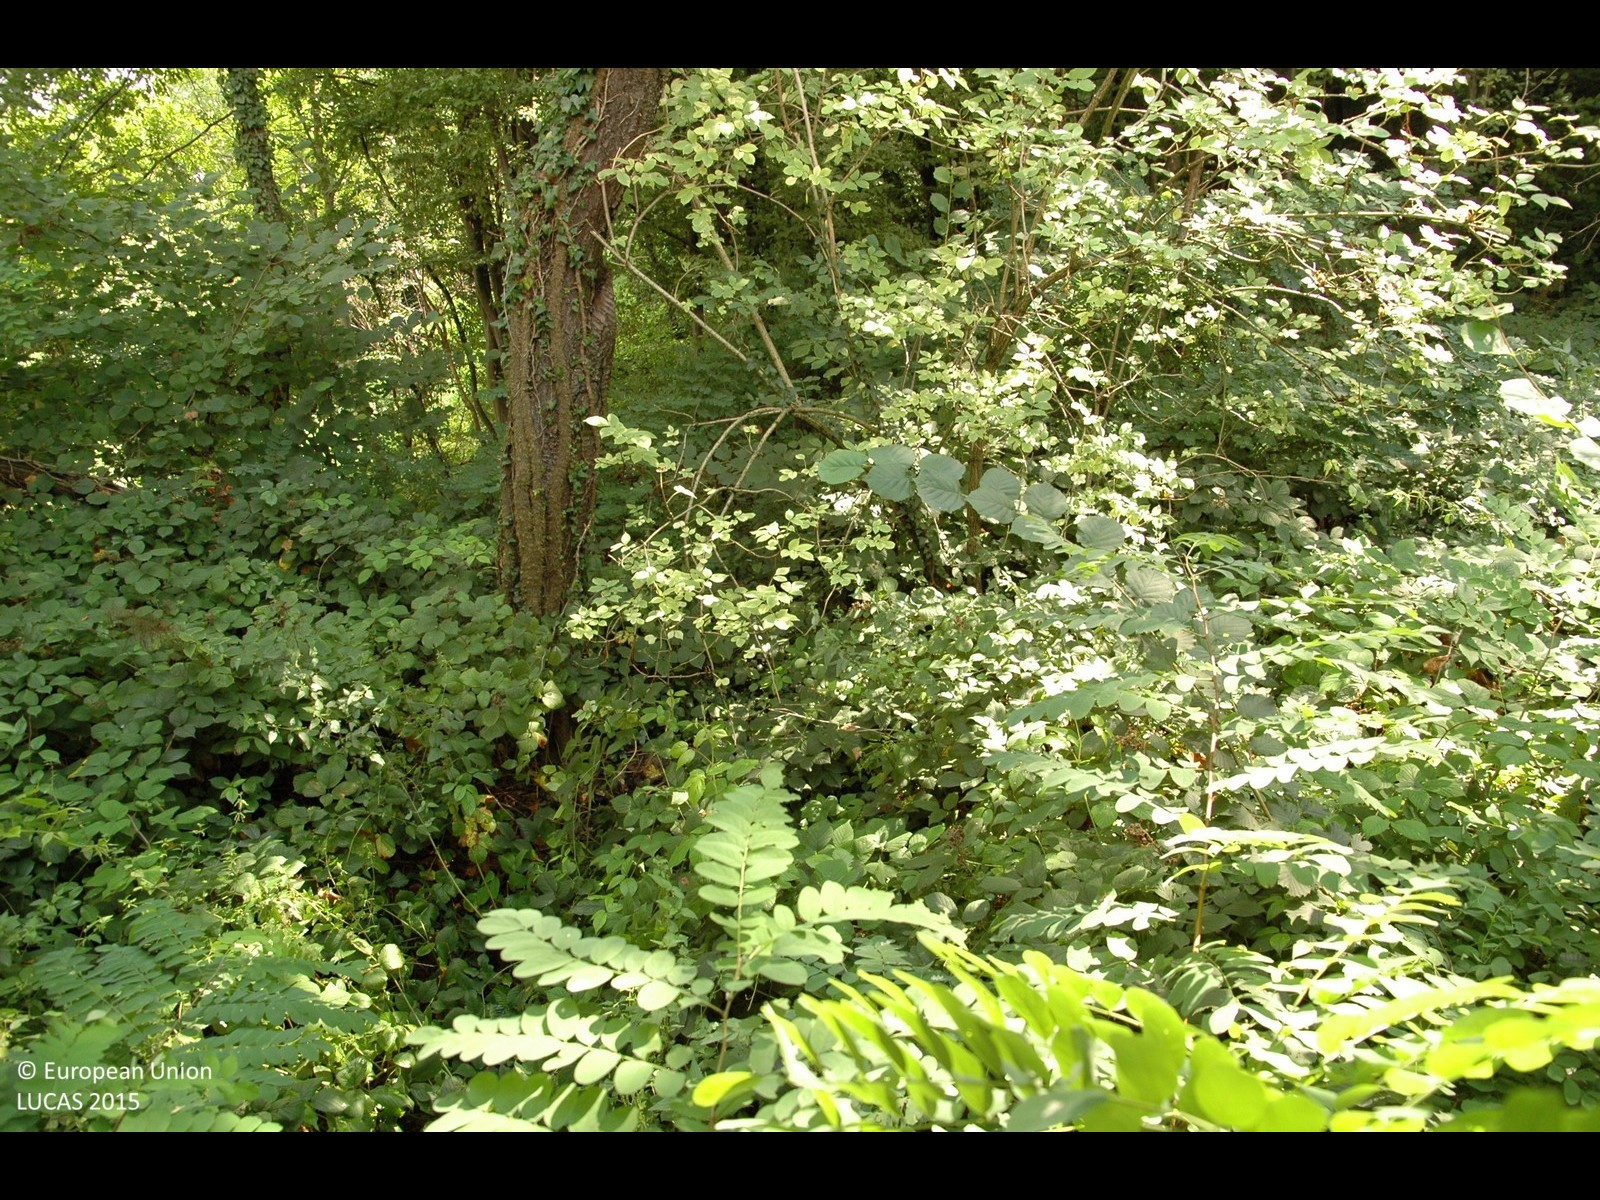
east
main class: Woodland
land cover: Broadleaved woodland
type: mesophytic deciduous forest
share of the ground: > 75 %
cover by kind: broadleaved forest trees 100 %
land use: Forestry
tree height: > 5 m
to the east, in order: Broadleaved woodland; Apple fruit; Tracks; Spontaneously vegetated surfaces
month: August
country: HR
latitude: 45.8584
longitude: 15.9870
